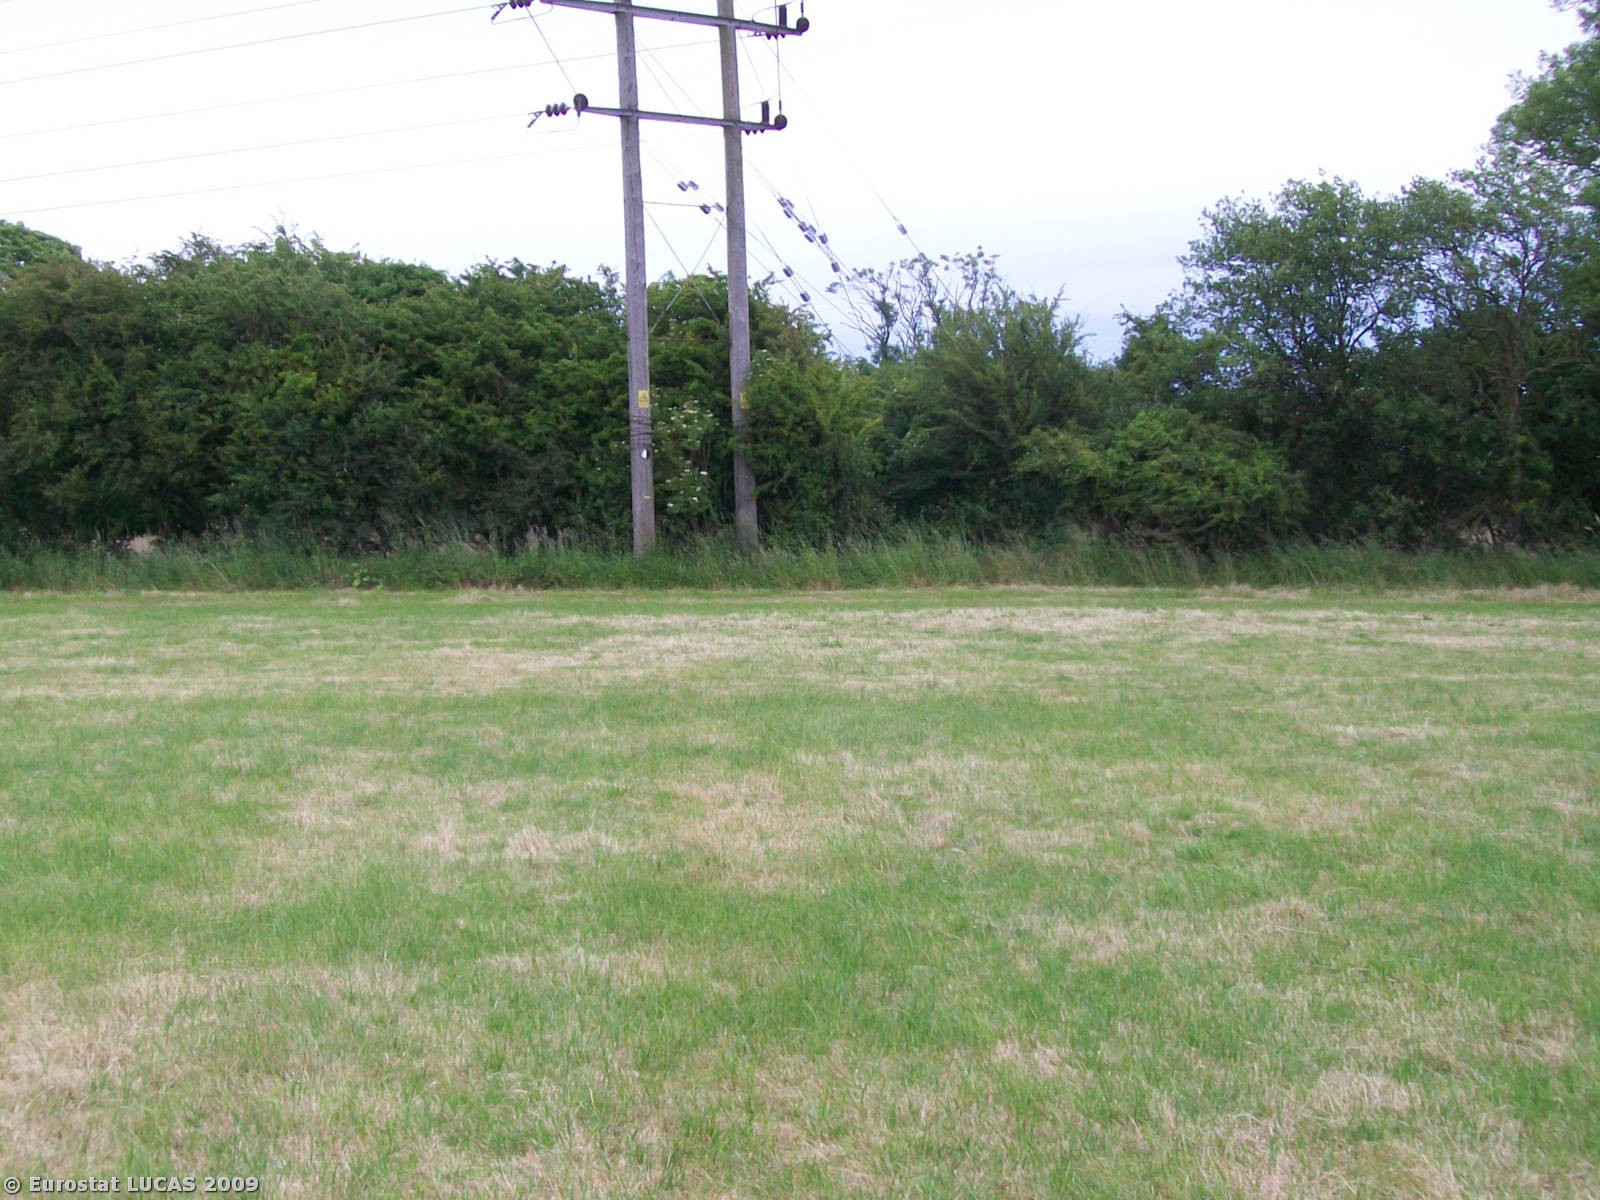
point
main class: Grassland
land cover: Grassland without tree/shrub cover
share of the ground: > 75 %
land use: Agriculture (excluding fallow land and kitchen gardens)
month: June
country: GB
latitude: 50.8324
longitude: -0.5887
